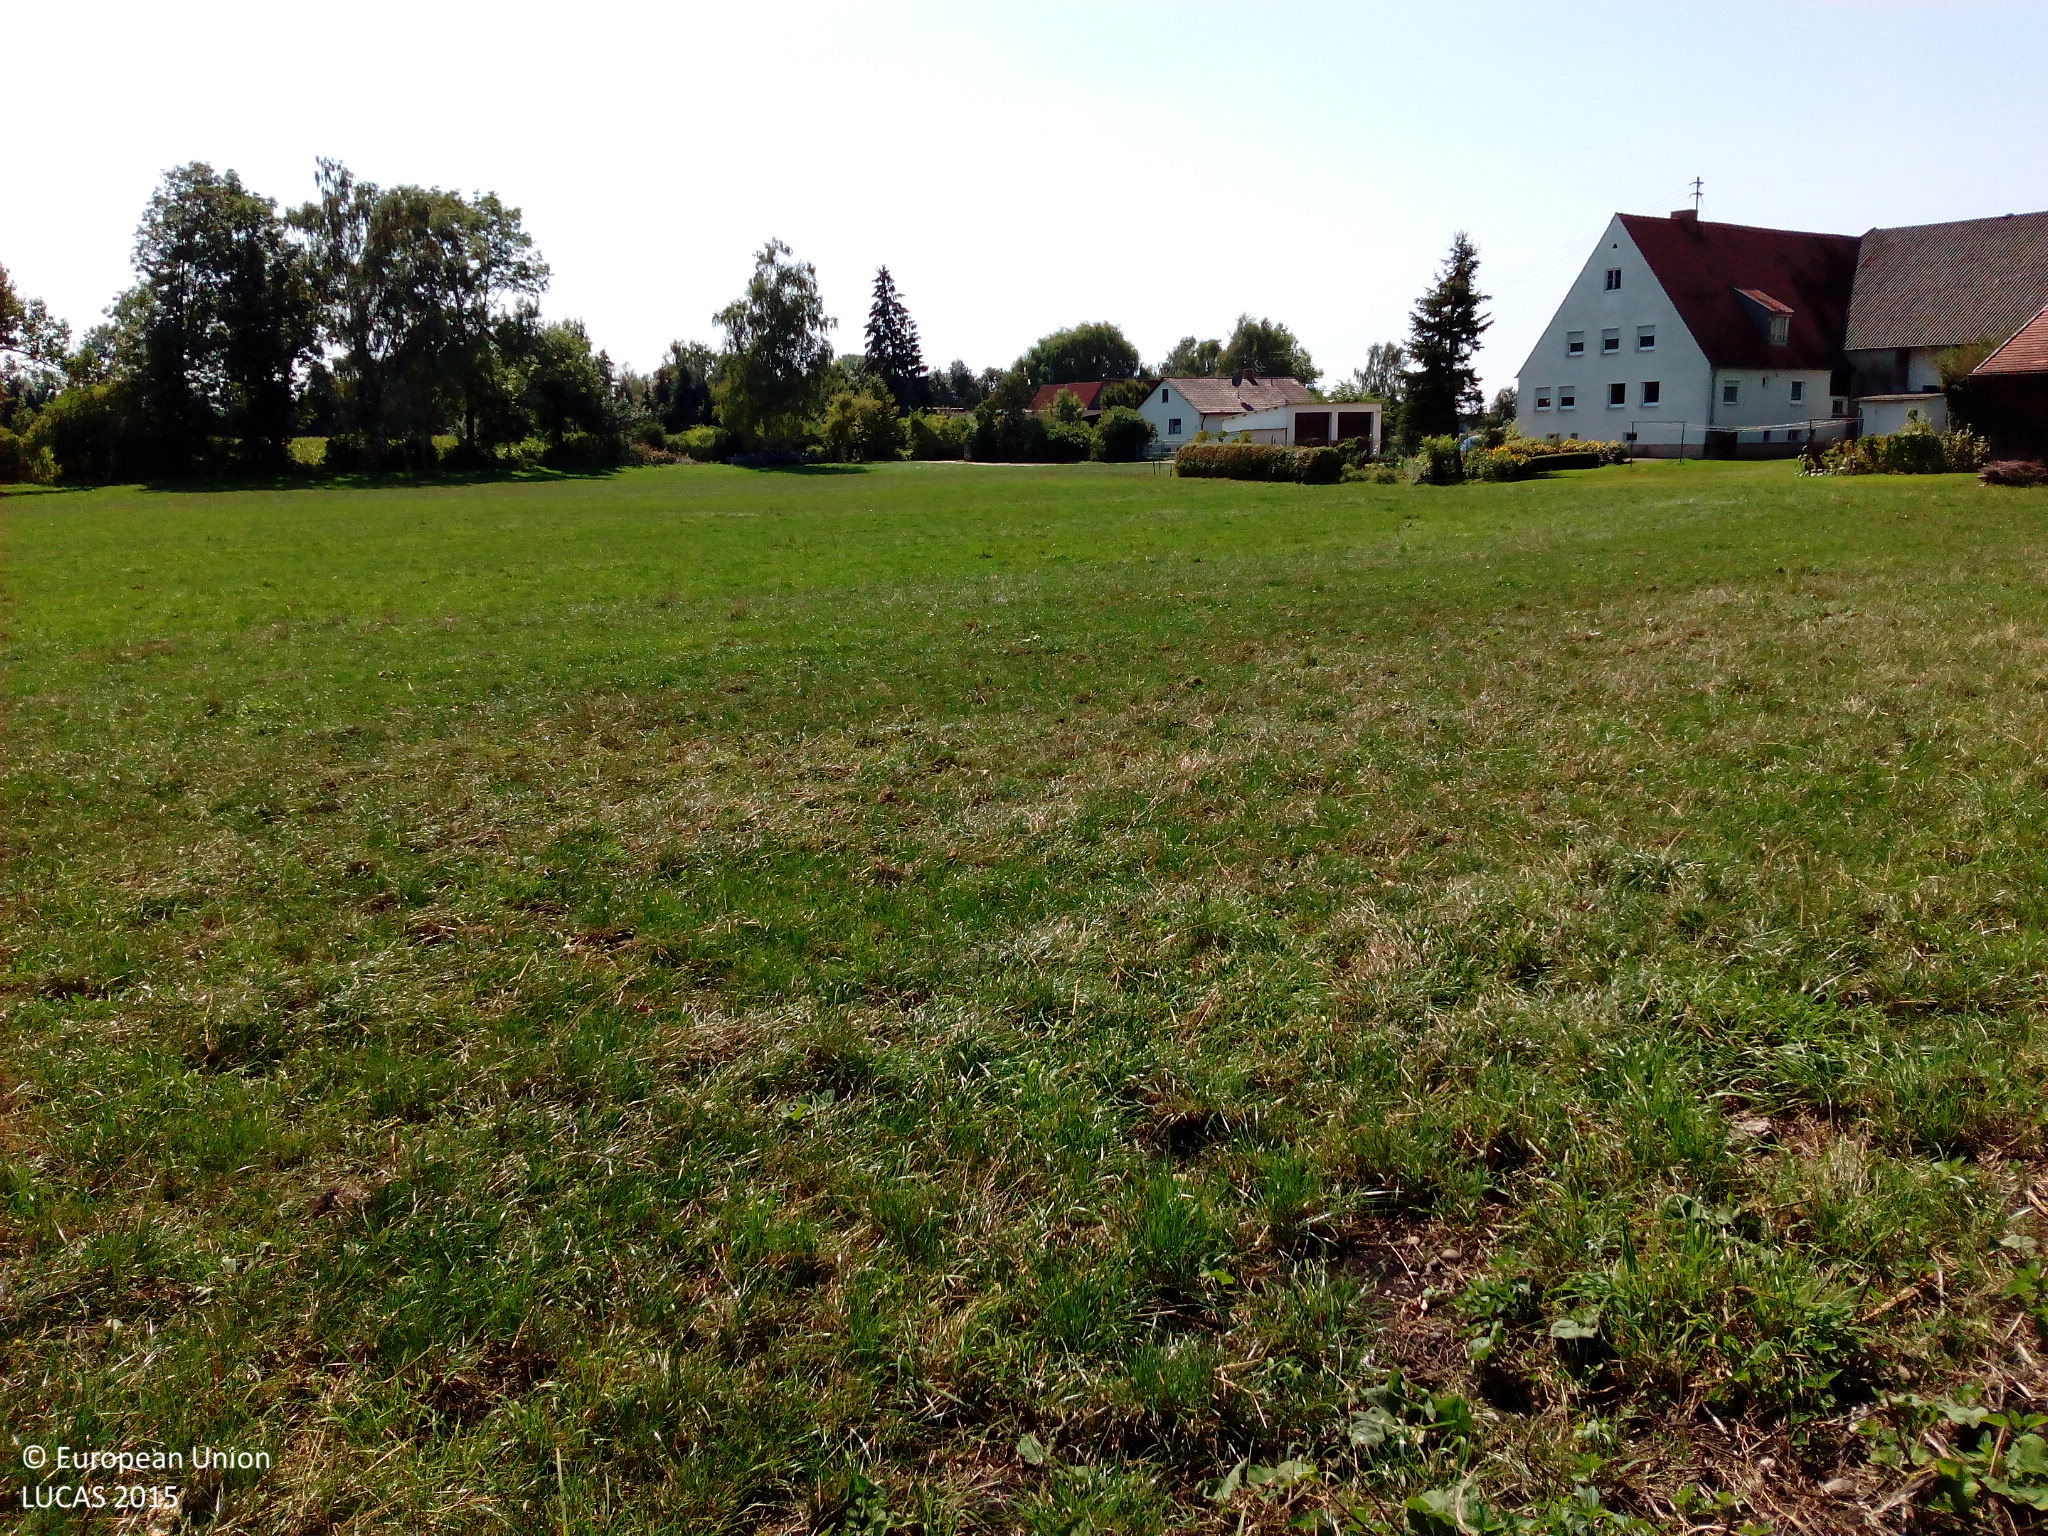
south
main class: Grassland
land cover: Grassland without tree/shrub cover
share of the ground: > 75 %
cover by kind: herbaceous plants 95 %, unconsolidated bare surface 5 %
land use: Agriculture (excluding fallow land and kitchen gardens)
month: August
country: DE
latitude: 48.4931
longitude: 10.2570
